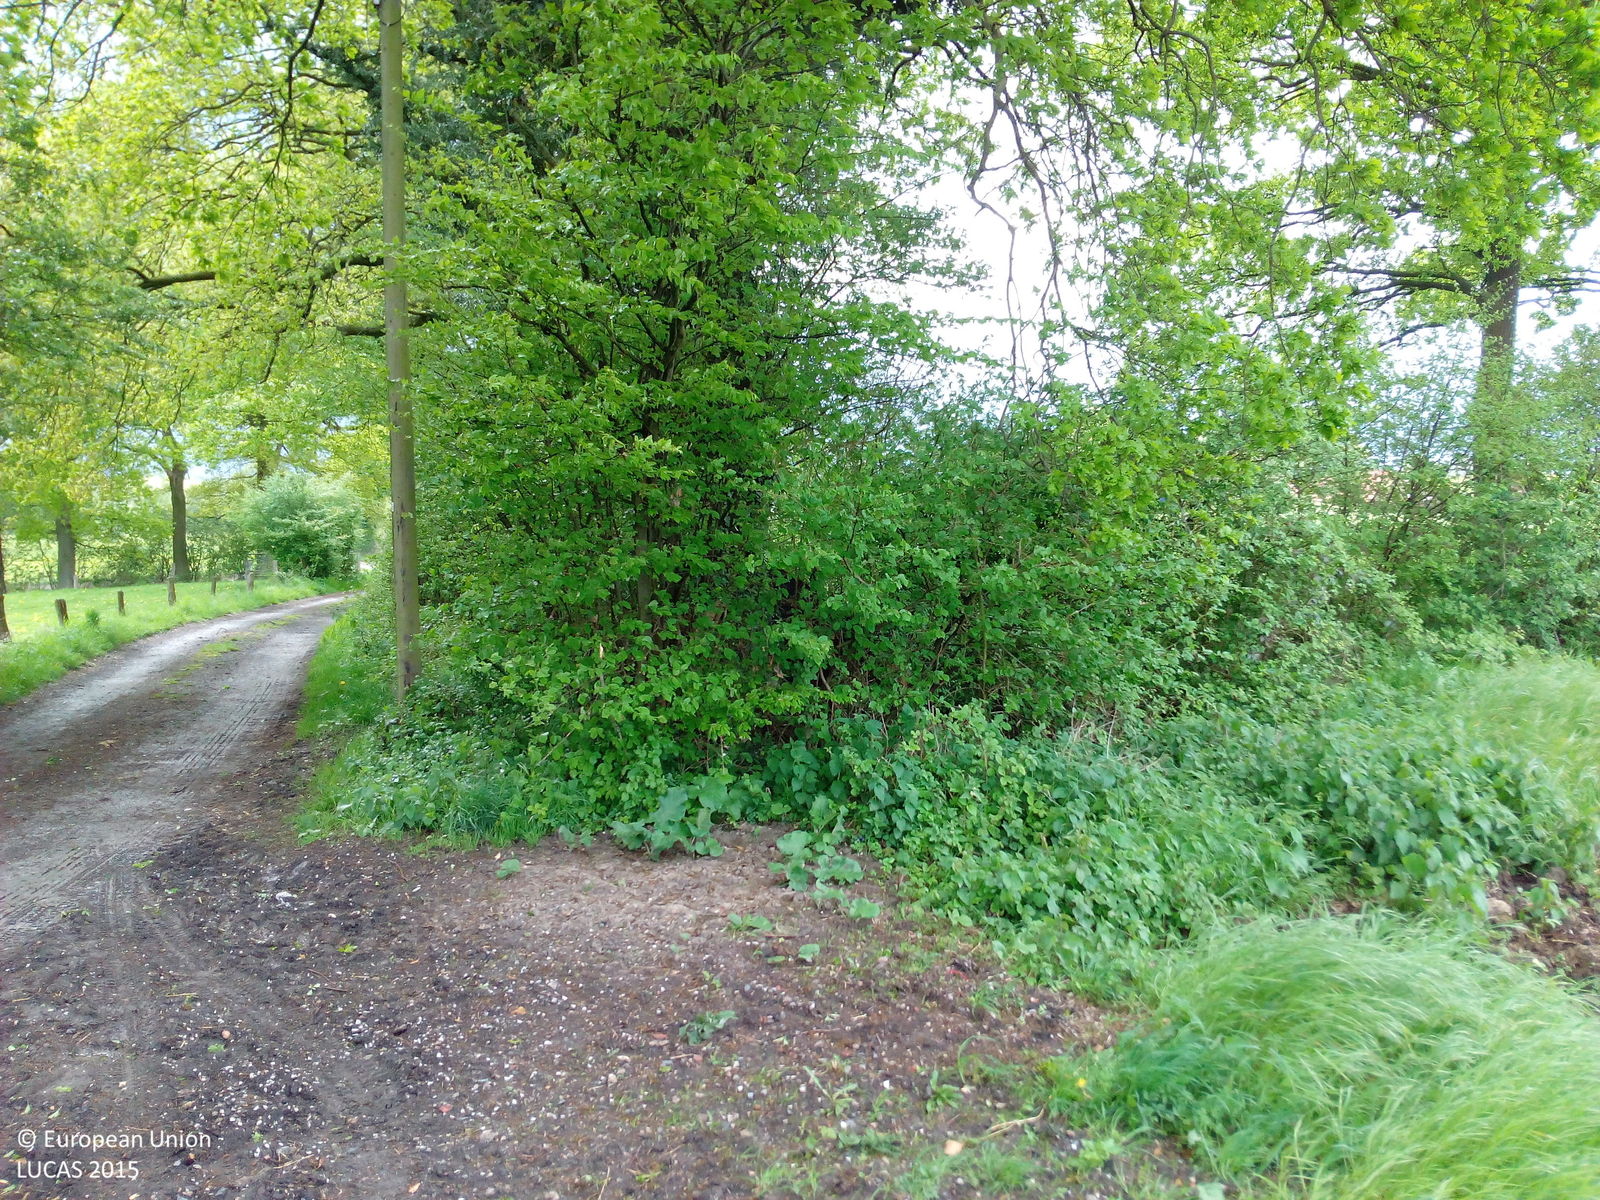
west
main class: Cropland
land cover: Maize
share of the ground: < 10 %
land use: Agriculture (excluding fallow land and kitchen gardens)
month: May
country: DE
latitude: 52.0623
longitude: 7.4477
